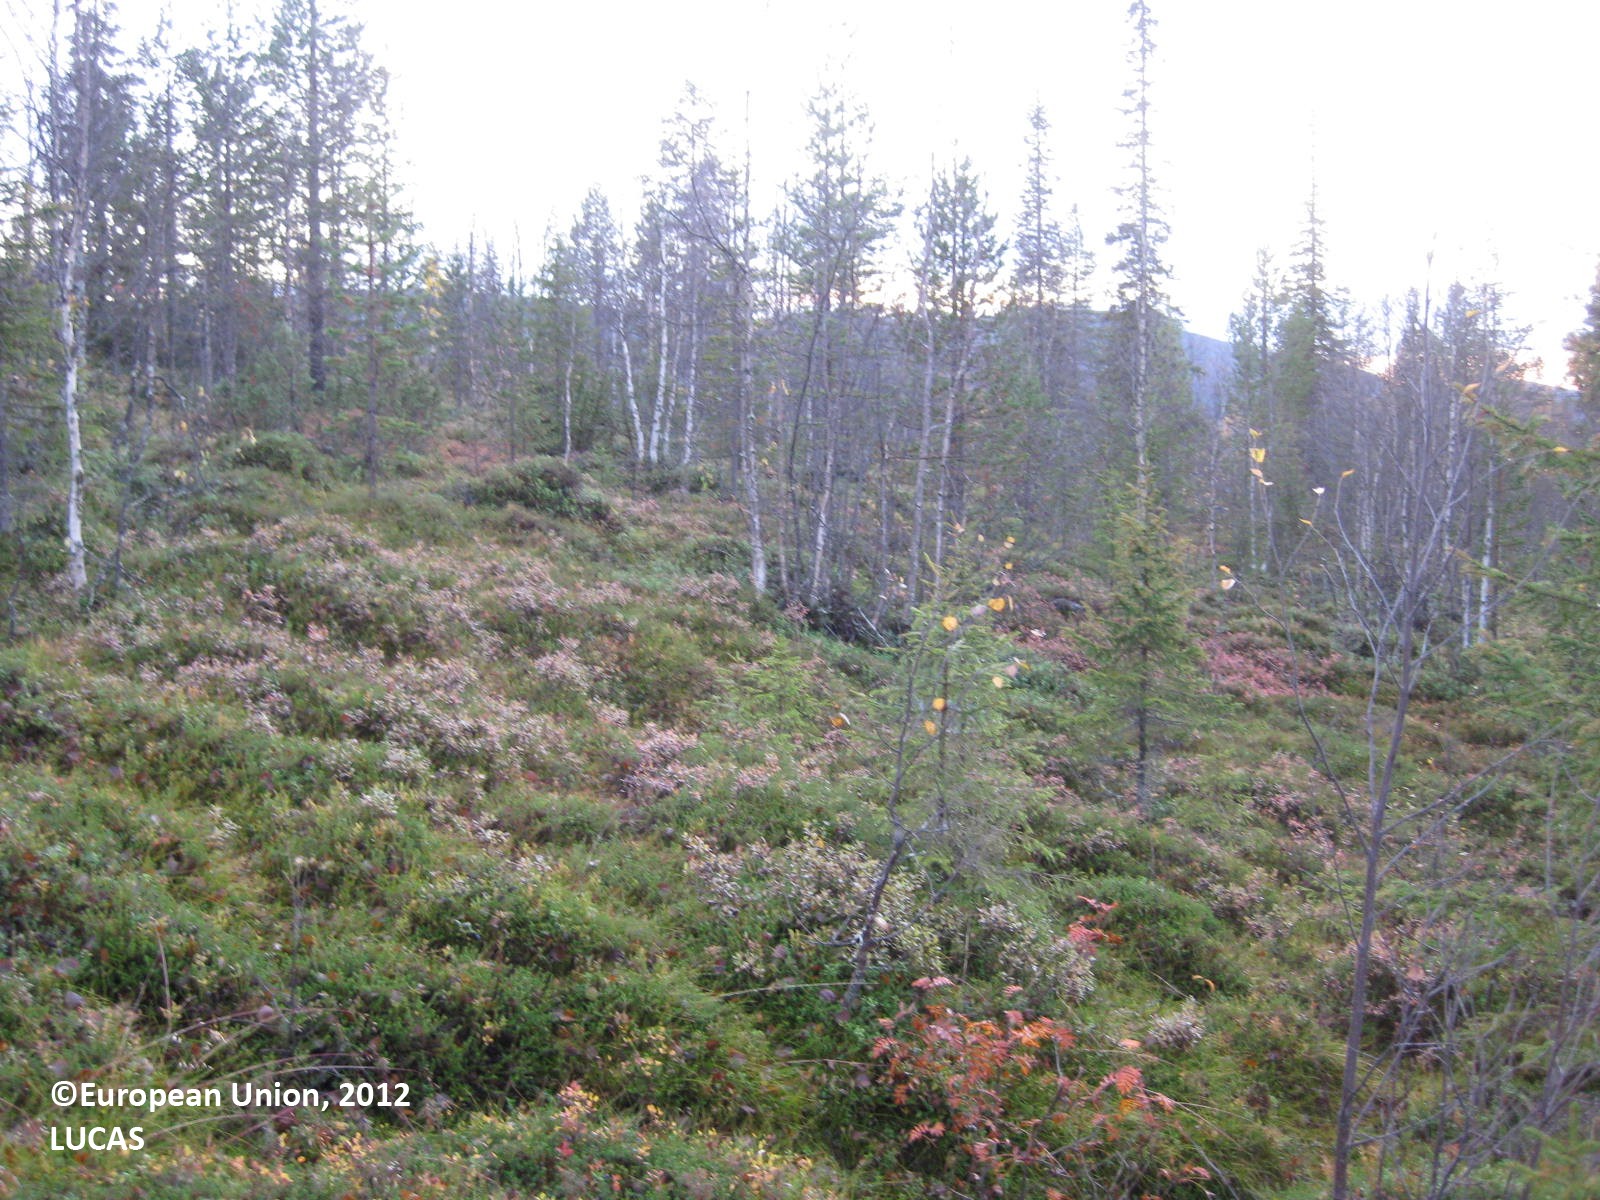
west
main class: Woodland
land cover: Other mixed woodland
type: boreal forest
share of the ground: 25 - 50 %
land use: Semi-natural and natural areas not in use
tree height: > 5 m
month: September
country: FI
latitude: 68.1526
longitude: 24.1504
